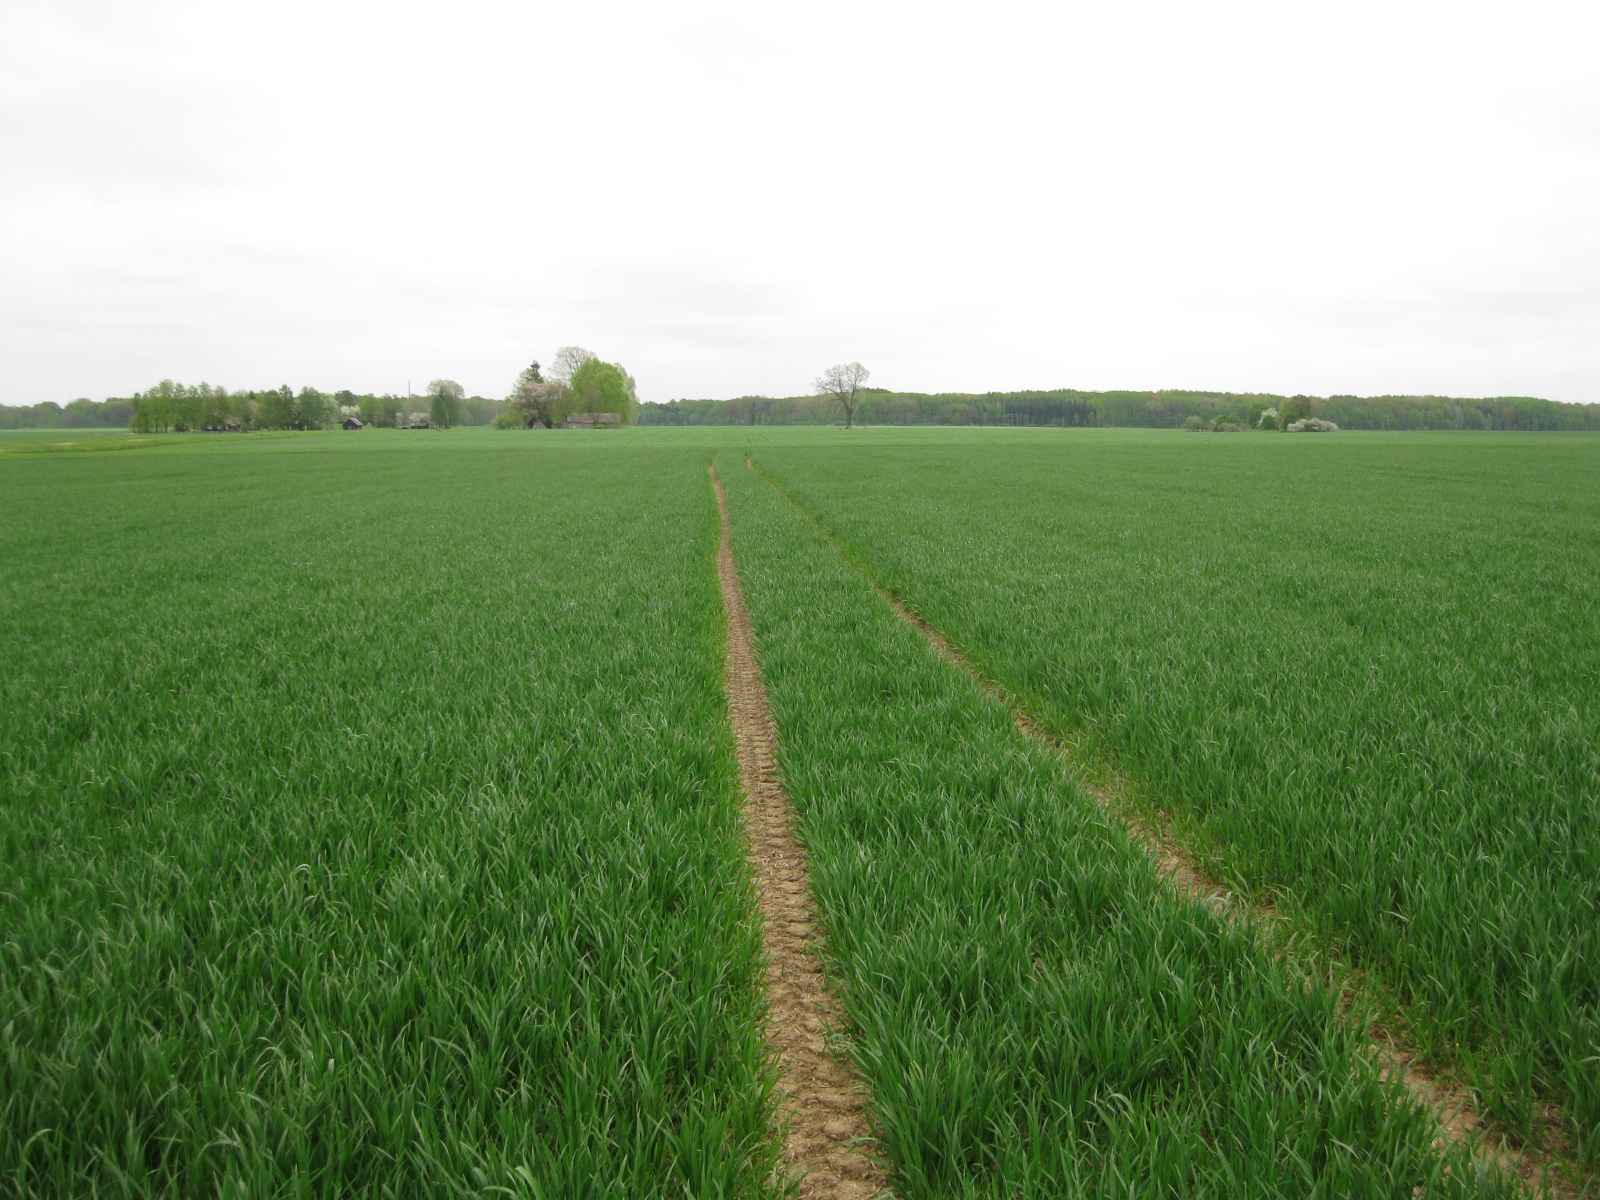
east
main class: Cropland
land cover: Common wheat
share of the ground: > 75 %
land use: Agriculture (excluding fallow land and kitchen gardens)
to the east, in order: Common wheat
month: May
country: LT
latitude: 55.9939
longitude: 24.3802
